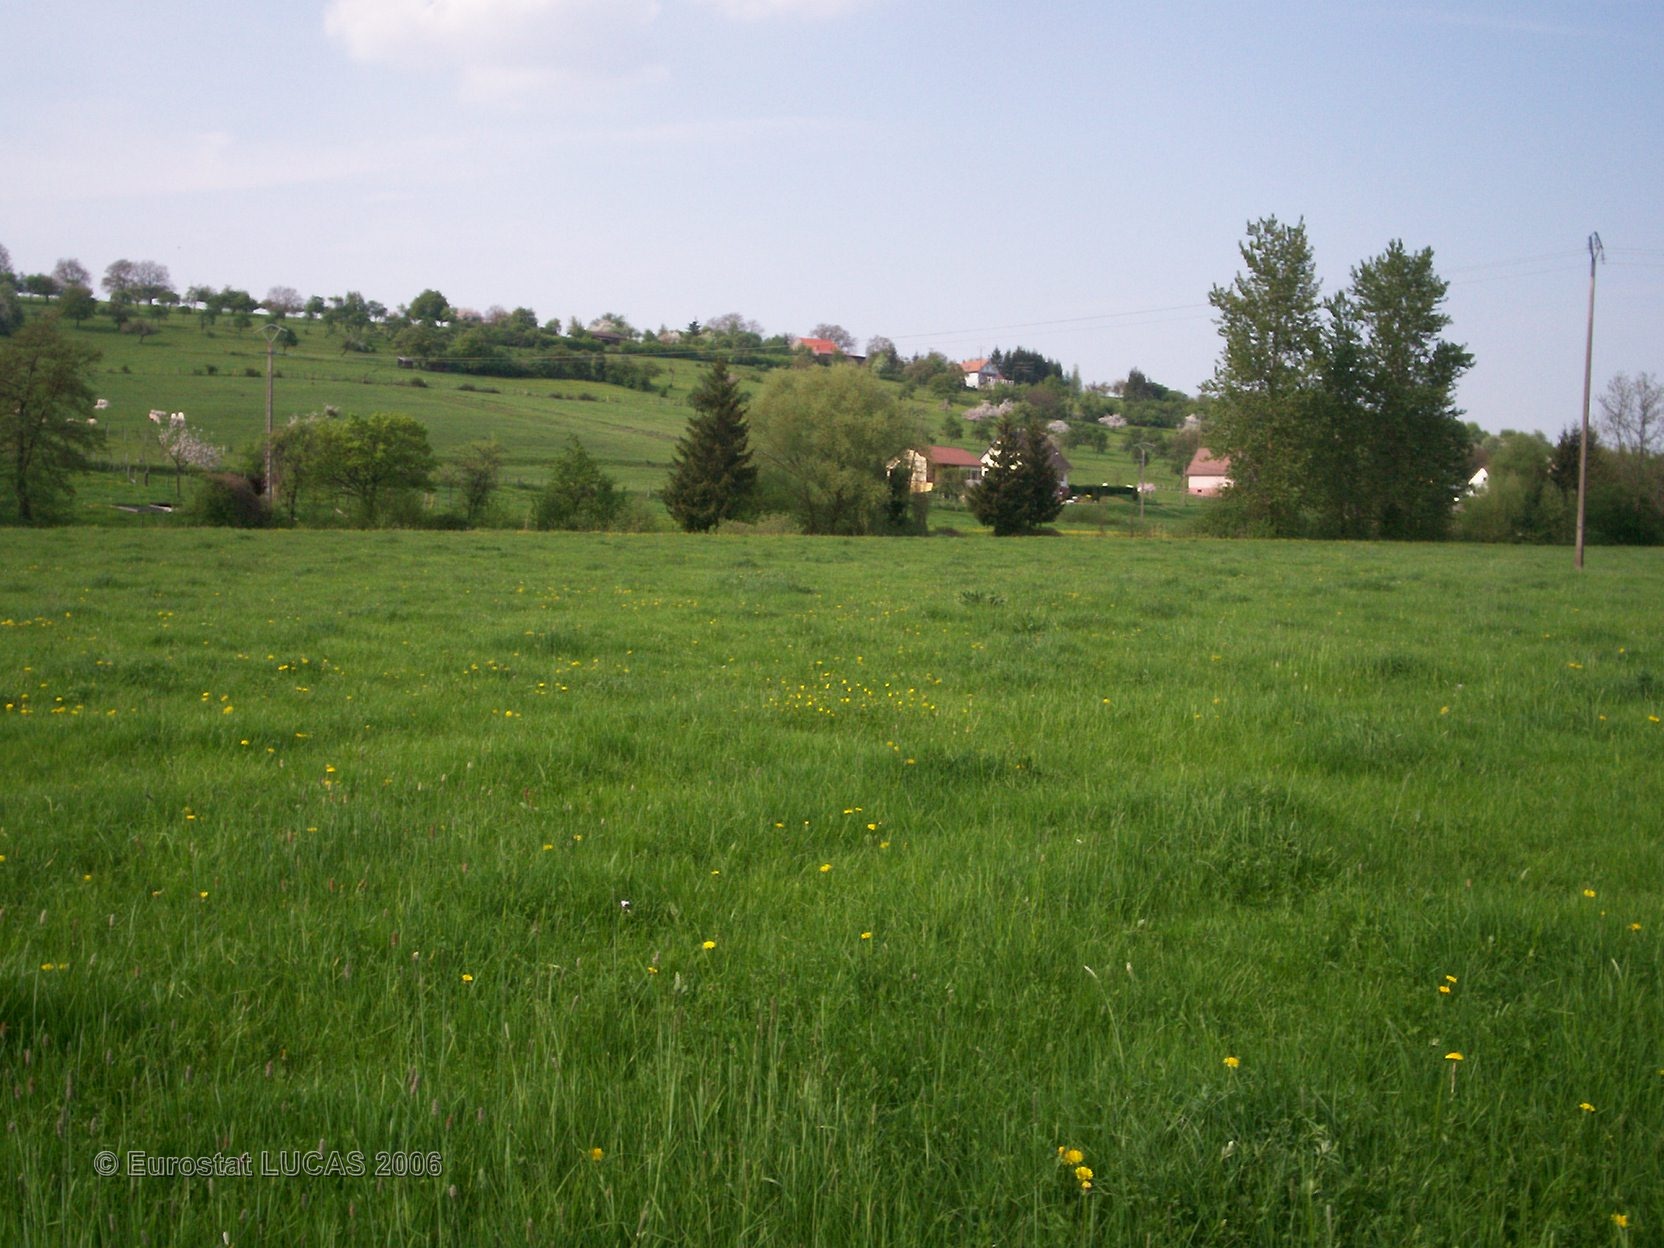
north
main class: Grassland
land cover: Grassland without tree/shrub cover
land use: Agriculture (excluding fallow land and kitchen gardens)
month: May
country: FR
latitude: 48.9047
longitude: 7.0673
